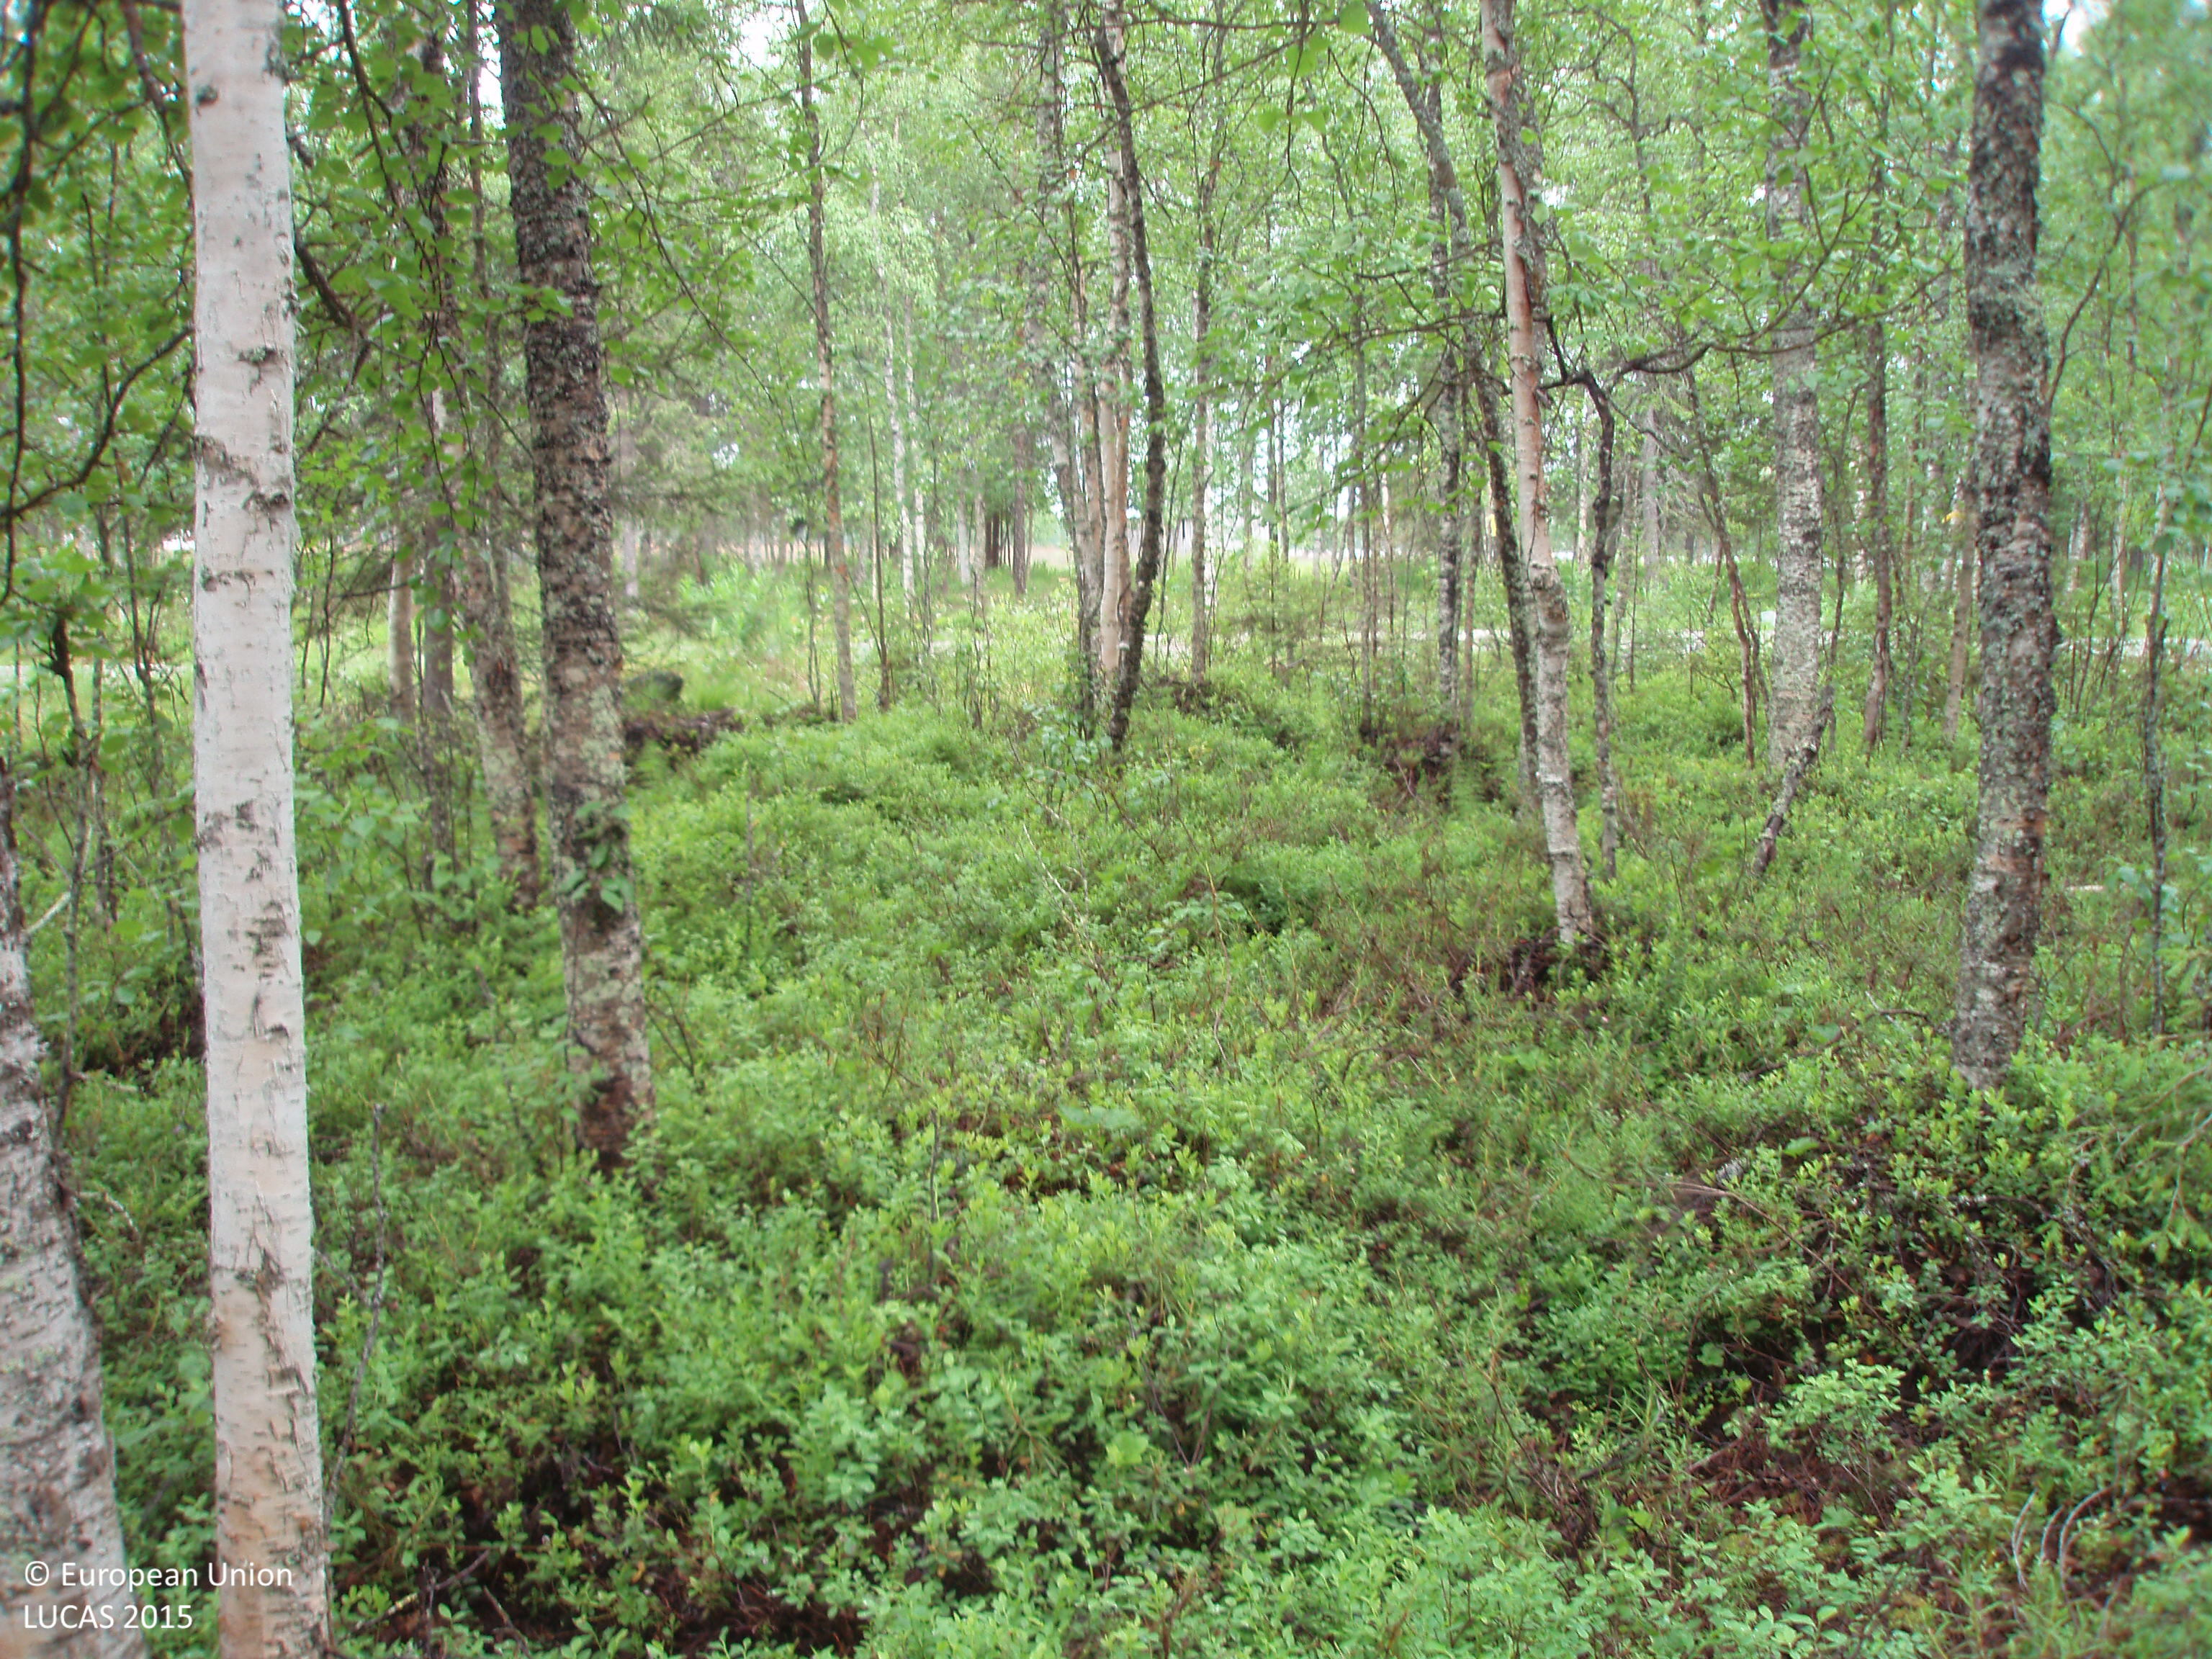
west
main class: Woodland
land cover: Spruce dominated mixed woodland
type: boreal forest
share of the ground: > 75 %
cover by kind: broadleaved forest trees 50 %, coniferous forest trees 35 %, shrubs 15 %
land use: Forestry
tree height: > 5 m
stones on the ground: < 10 %
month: July
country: FI
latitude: 67.4645
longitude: 27.0852
